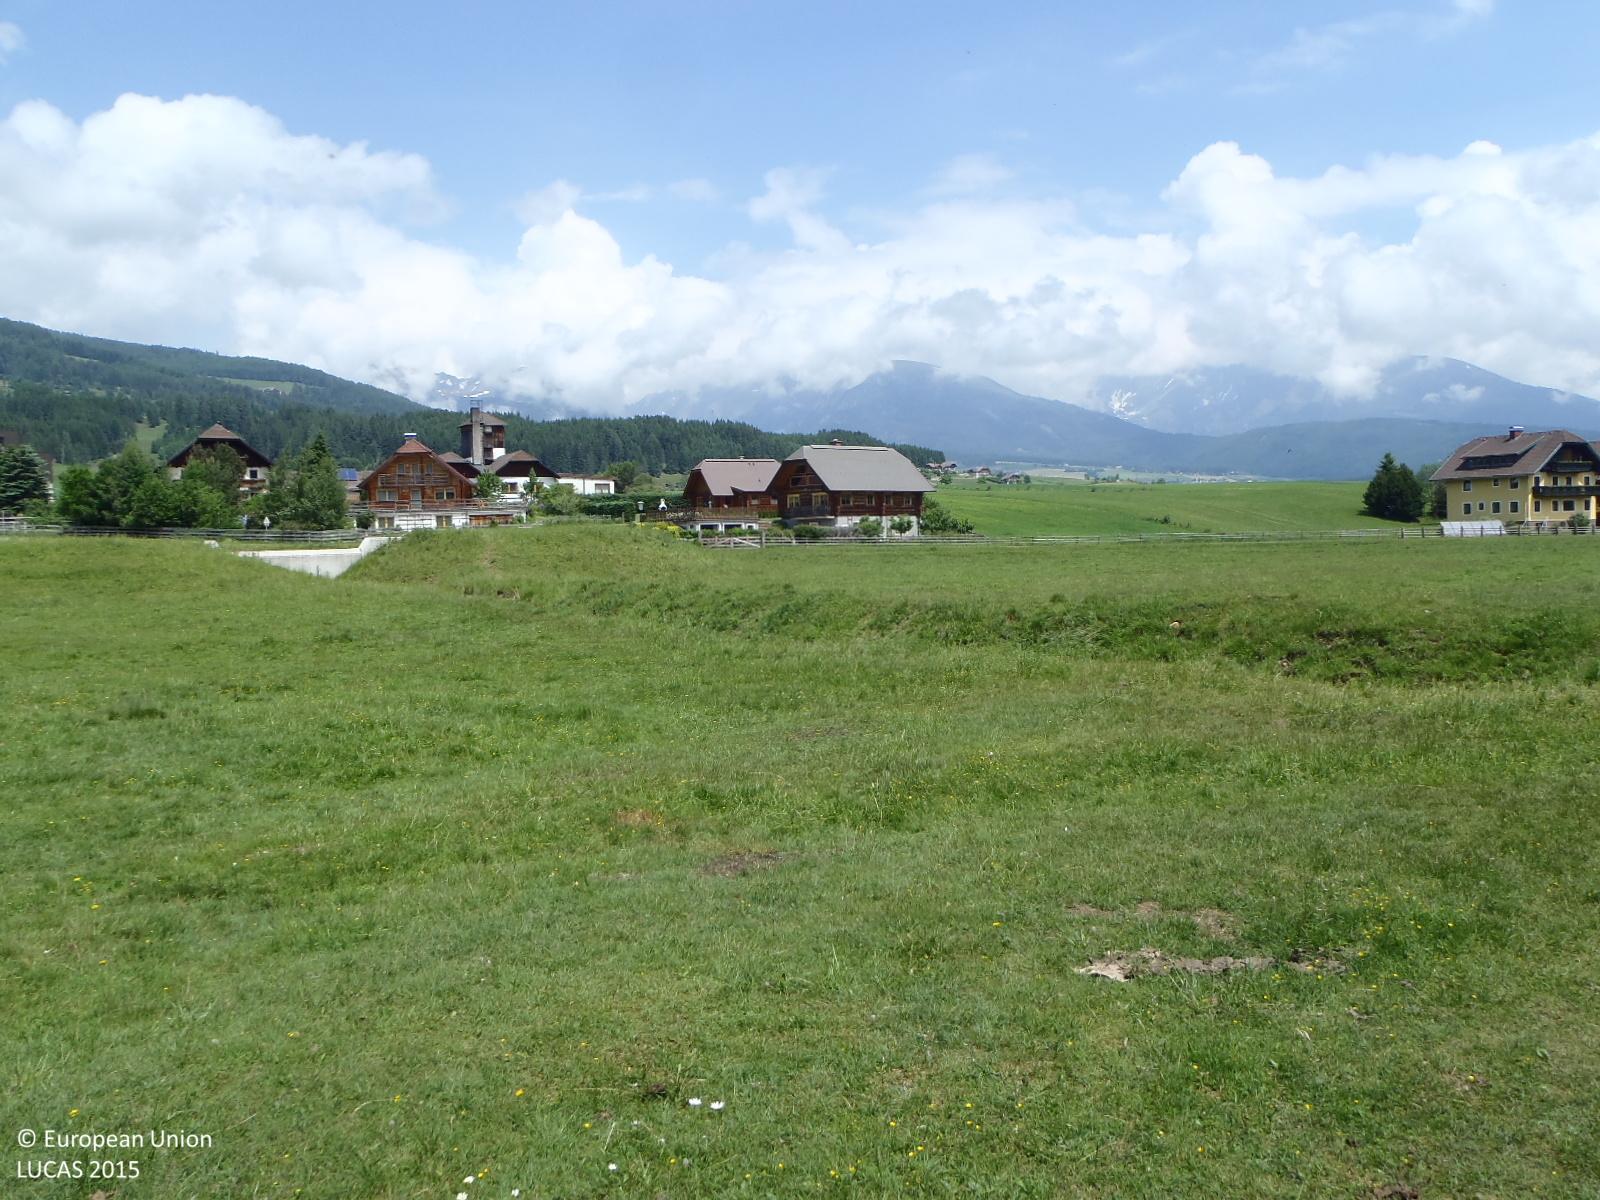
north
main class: Grassland
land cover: Grassland without tree/shrub cover
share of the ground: > 75 %
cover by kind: herbaceous plants 100 %
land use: Agriculture (excluding fallow land and kitchen gardens)
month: June
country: AT
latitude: 47.1344
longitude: 13.7027
